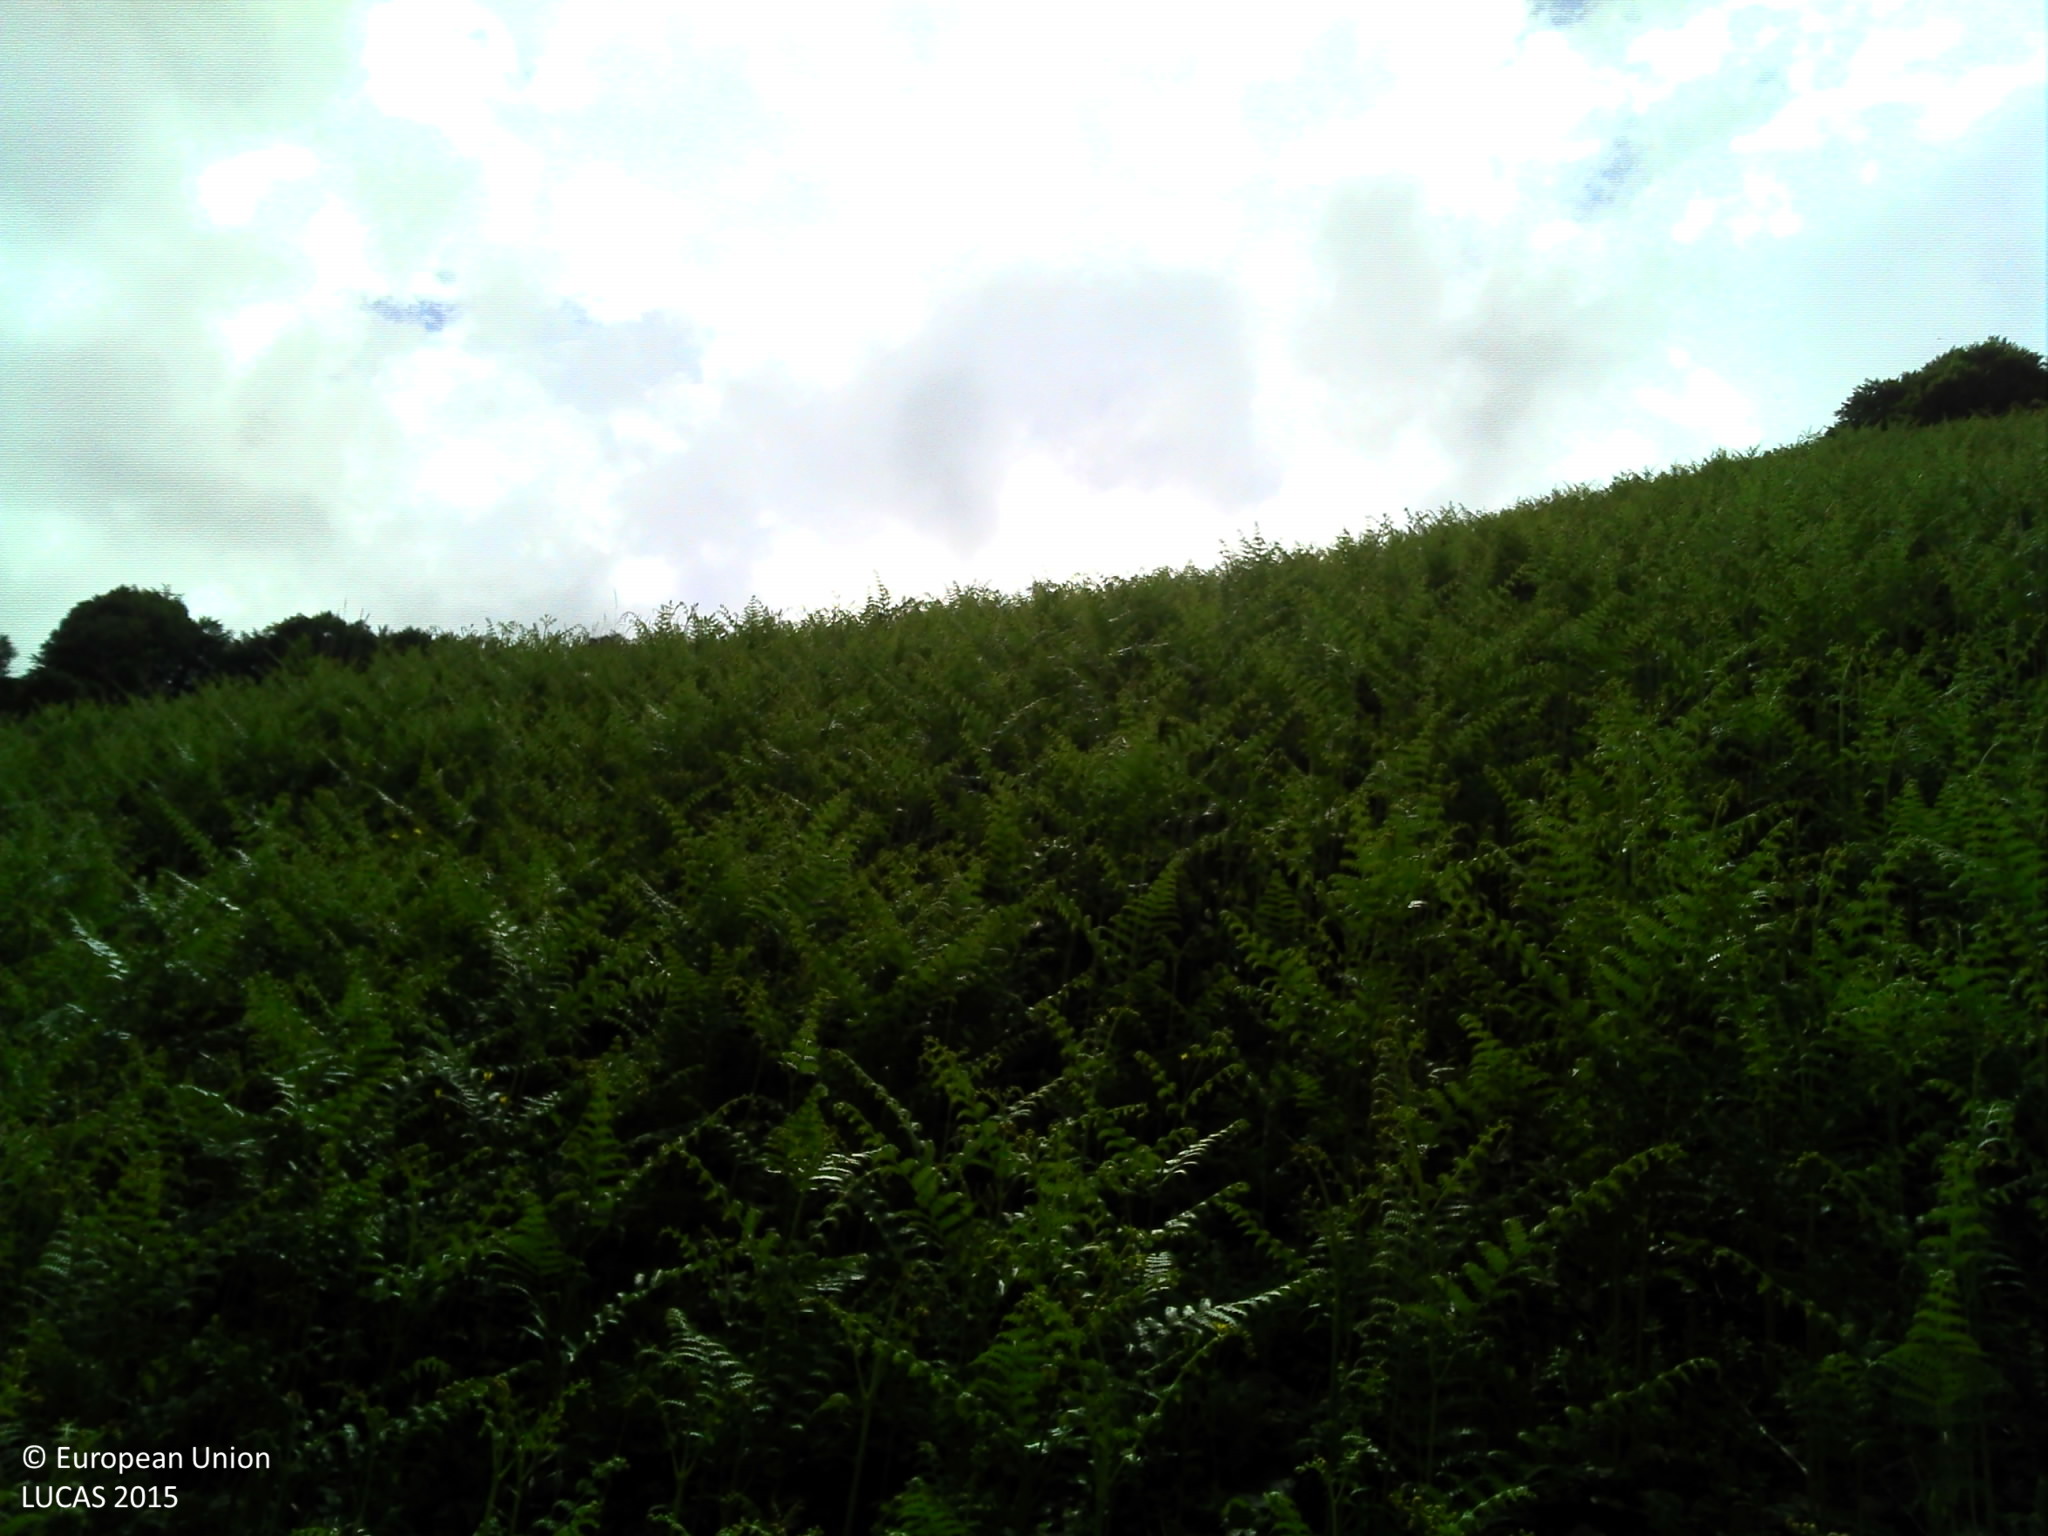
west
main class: Grassland
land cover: Grassland without tree/shrub cover
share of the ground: > 75 %
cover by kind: herbaceous plants 100 %
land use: Agriculture (excluding fallow land and kitchen gardens)
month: June
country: FR
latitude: 42.9123
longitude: -0.6262
